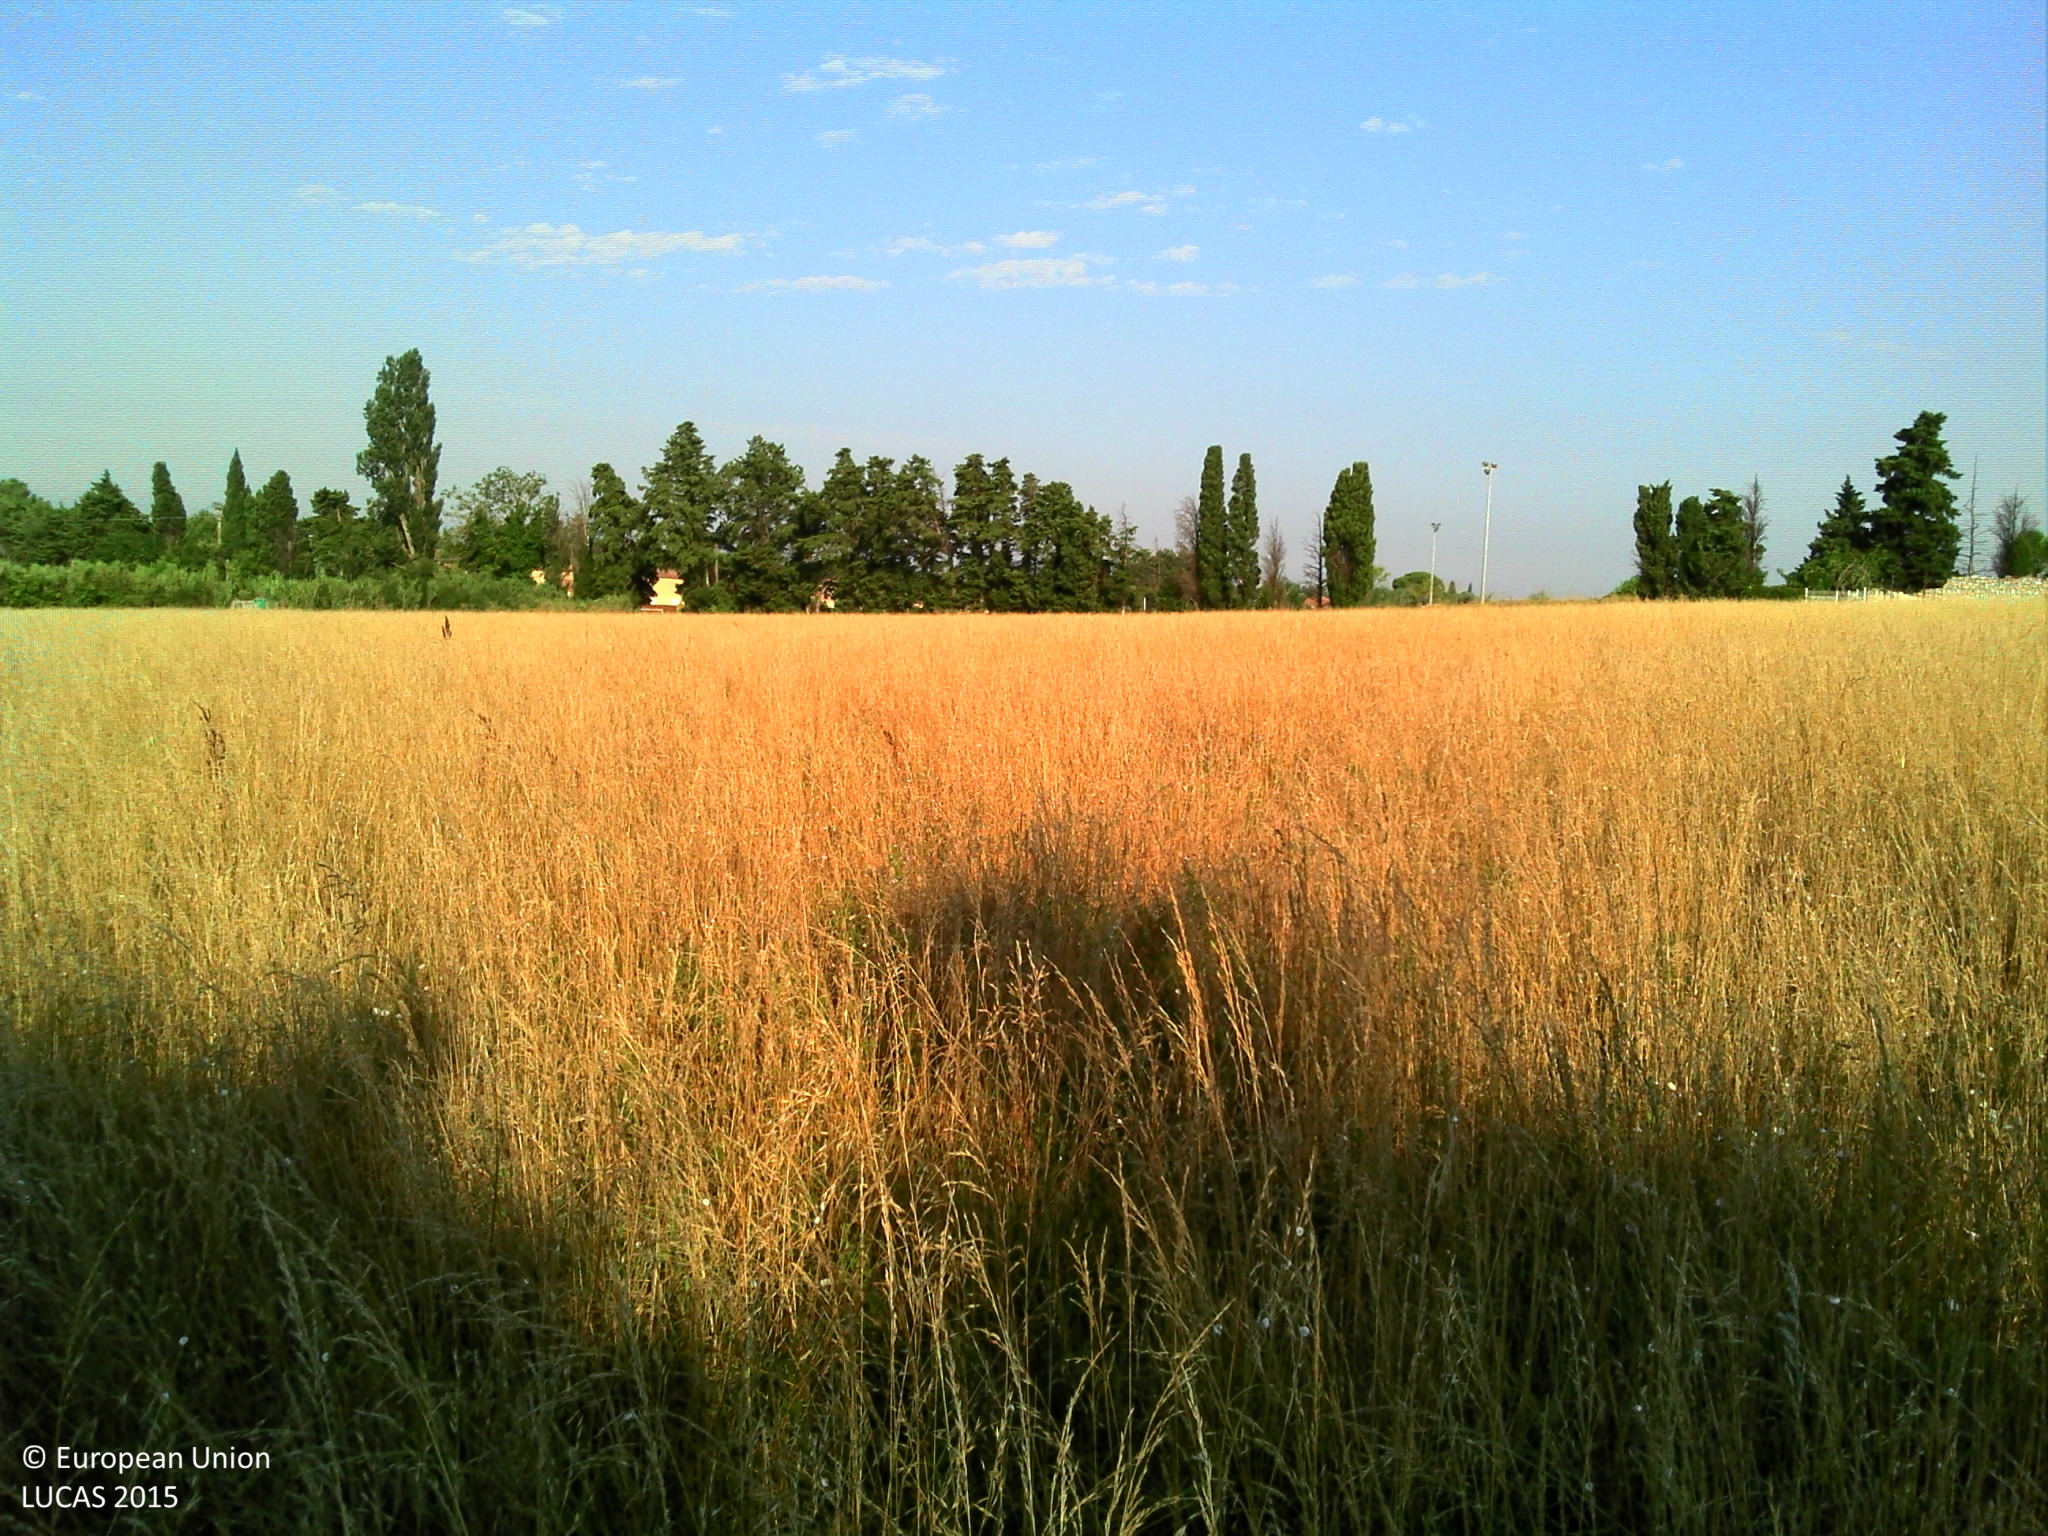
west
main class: Grassland
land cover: Grassland without tree/shrub cover
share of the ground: > 75 %
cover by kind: herbaceous plants 100 %
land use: Agriculture (excluding fallow land and kitchen gardens)
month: July
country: FR
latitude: 43.9607
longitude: 5.0359
